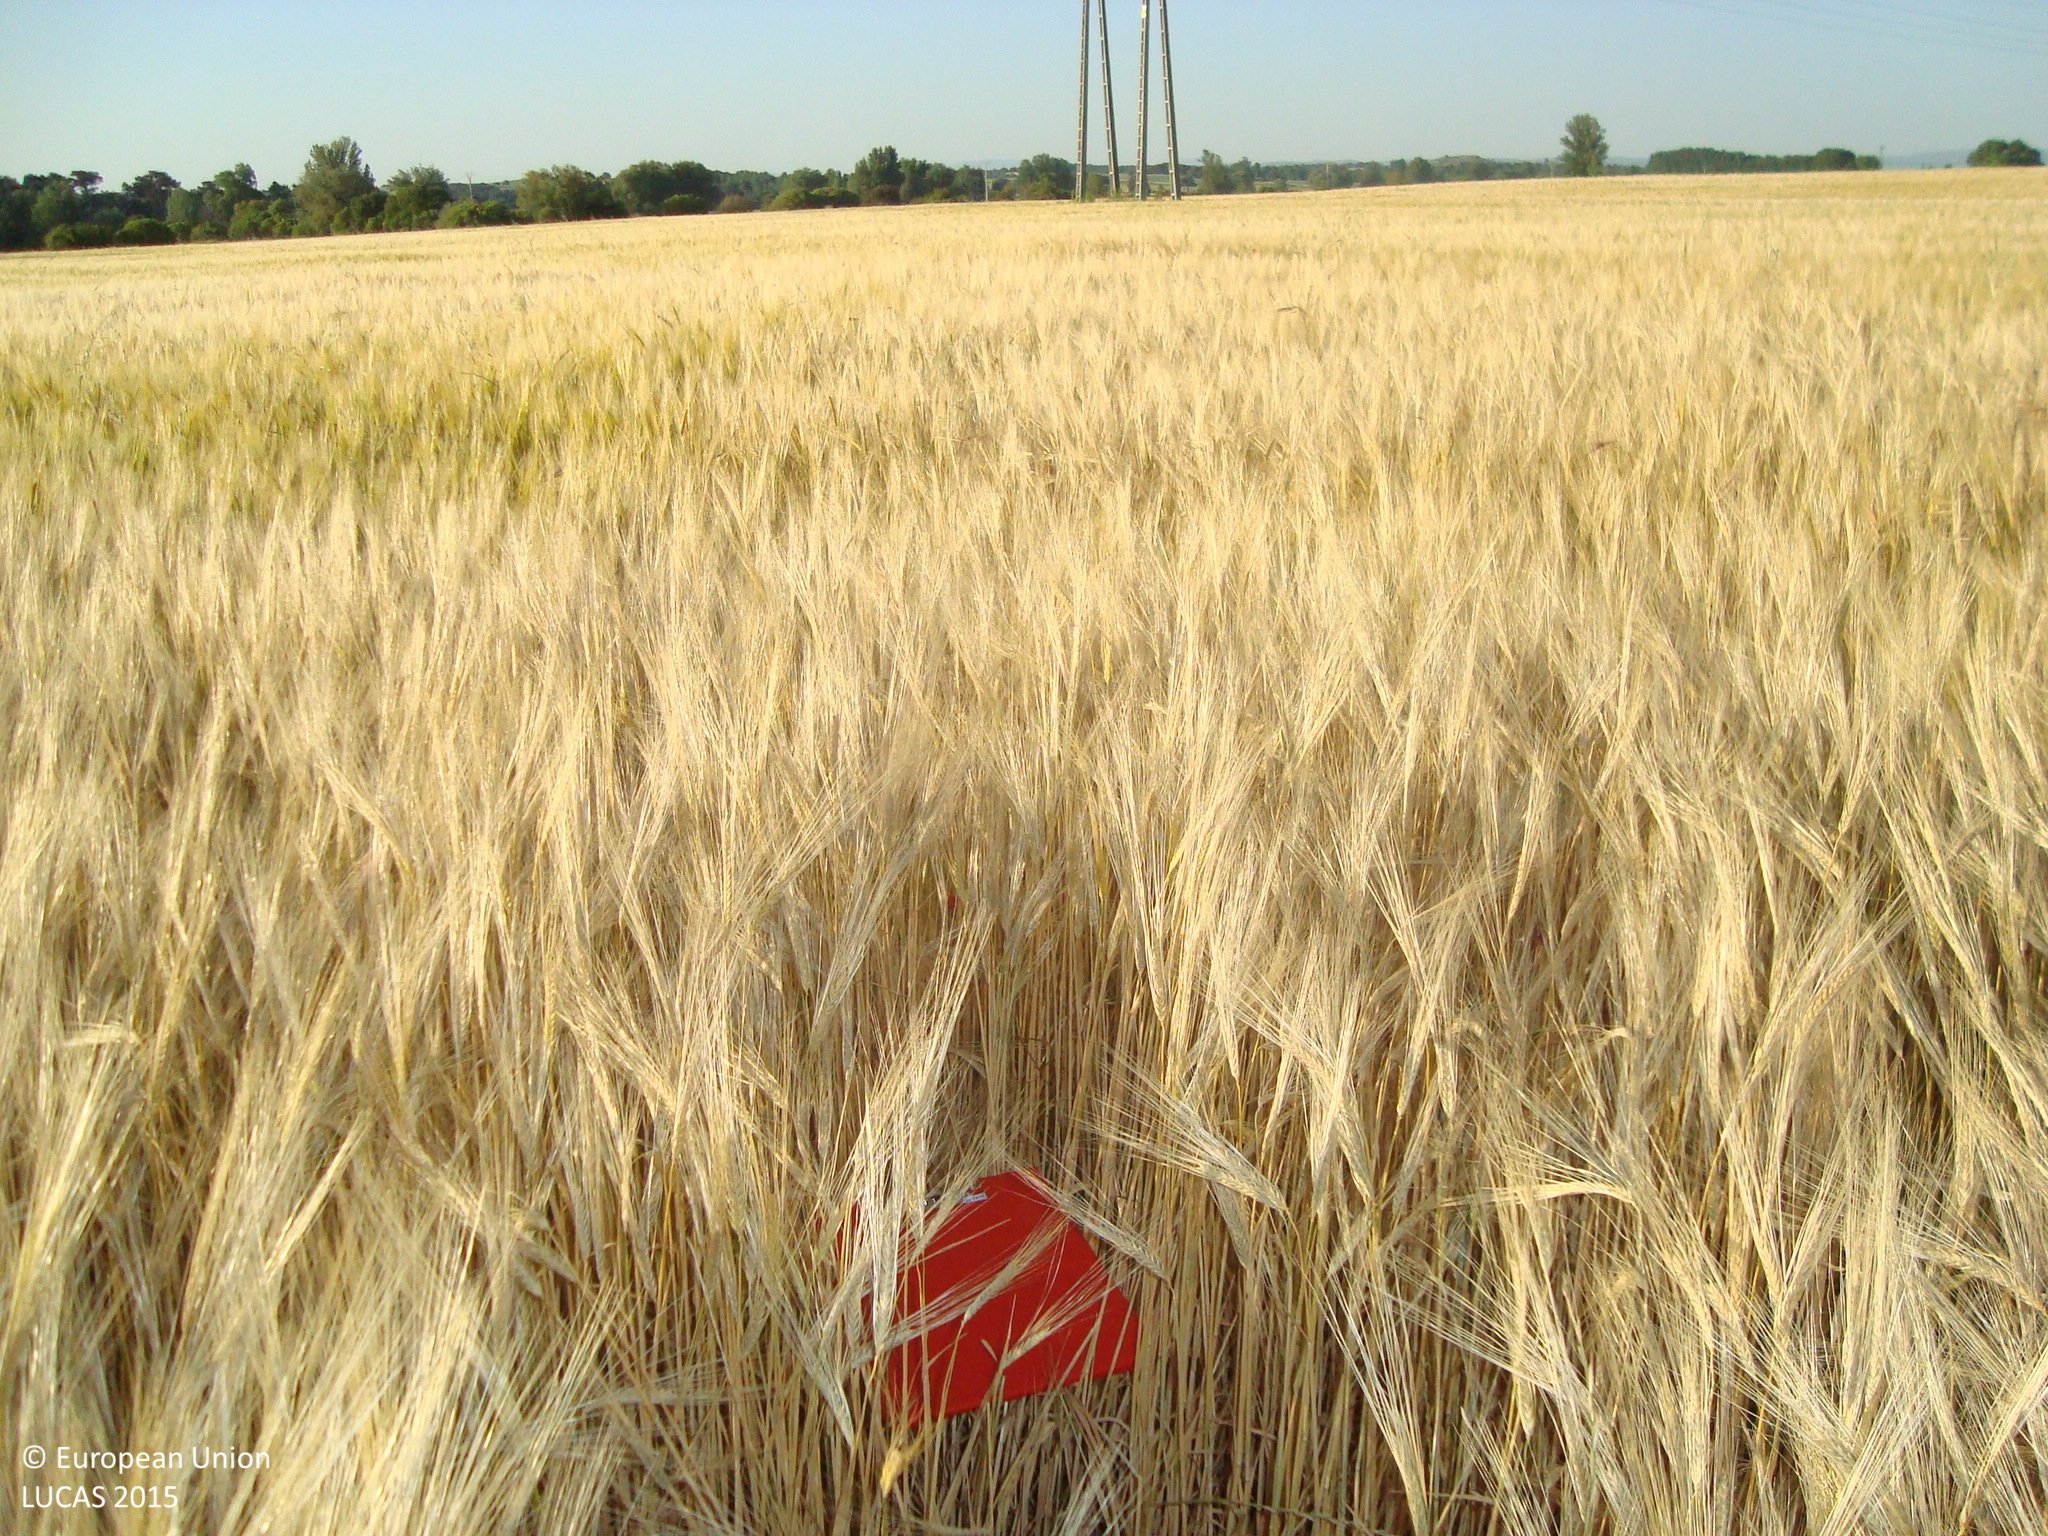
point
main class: Cropland
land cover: Barley
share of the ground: > 75 %
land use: Agriculture (excluding fallow land and kitchen gardens)
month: June
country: ES
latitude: 41.7252
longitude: -3.6488
